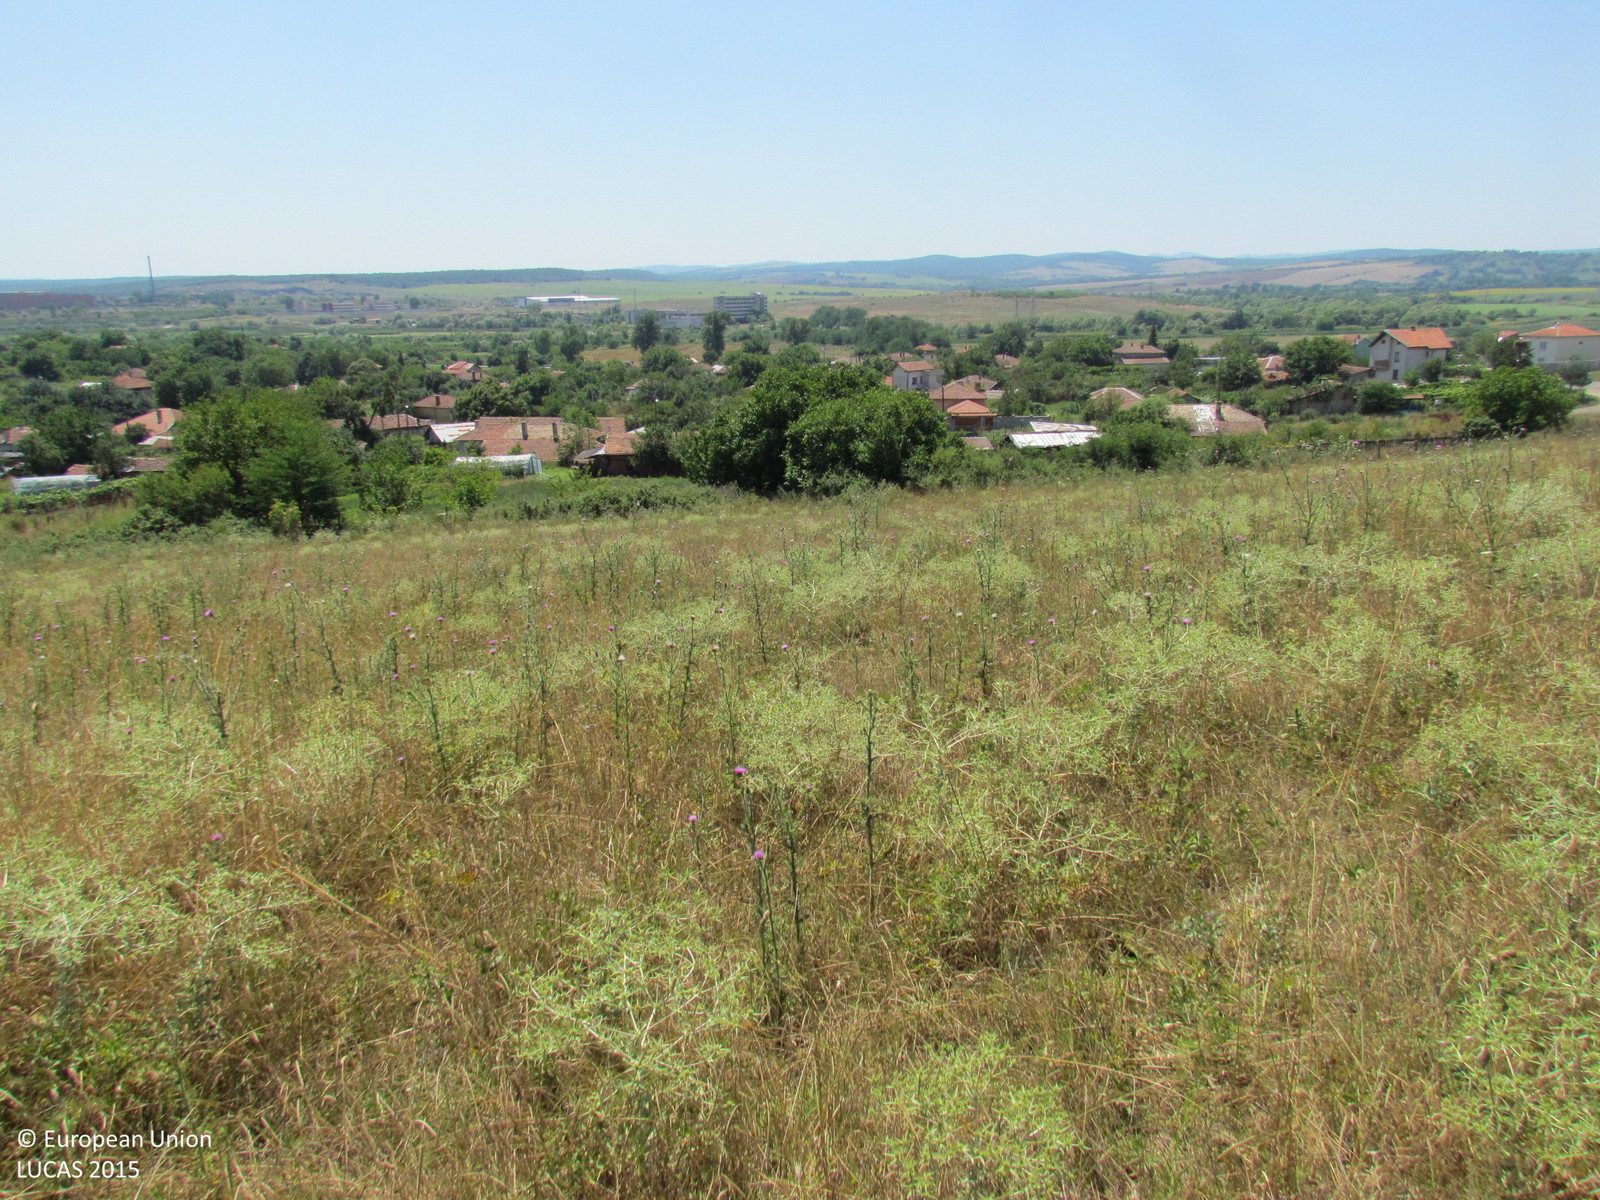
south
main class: Grassland
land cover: Grassland without tree/shrub cover
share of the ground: > 75 %
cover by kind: herbaceous plants 100 %
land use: Agriculture (excluding fallow land and kitchen gardens)
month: July
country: BG
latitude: 42.3910
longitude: 27.2746
